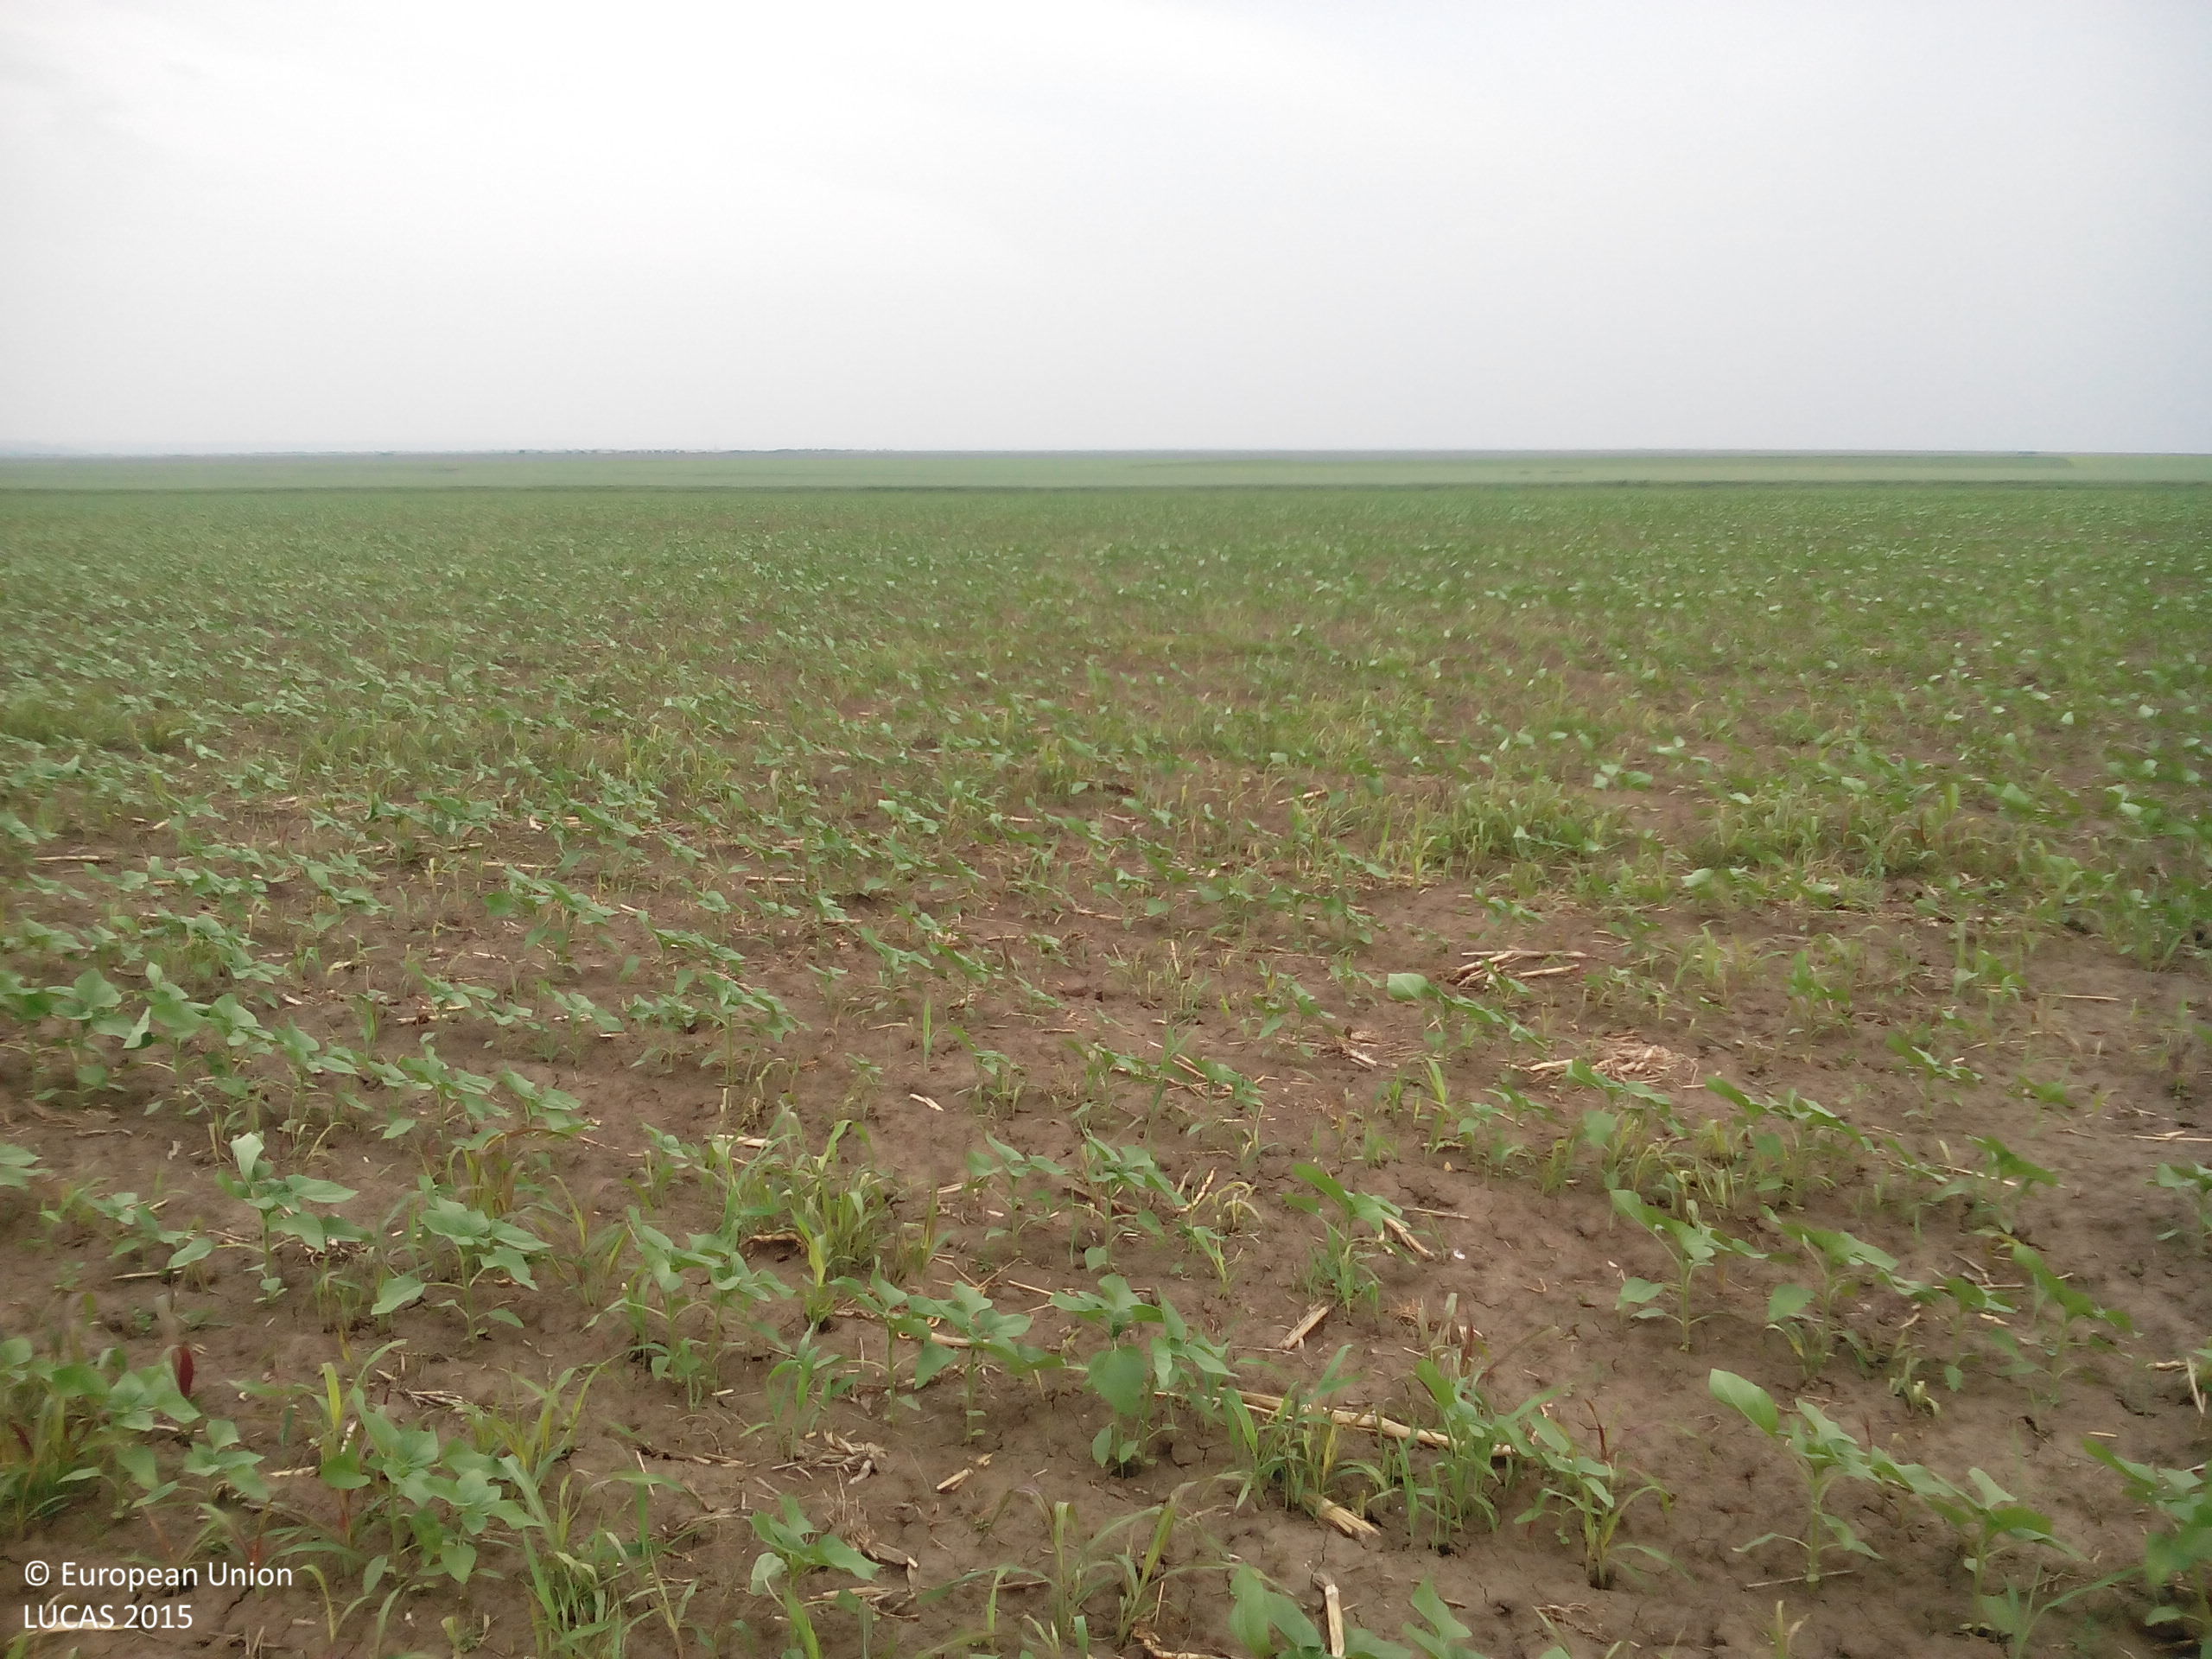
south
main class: Cropland
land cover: Sunflower
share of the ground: 25 - 50 %
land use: Agriculture (excluding fallow land and kitchen gardens)
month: May
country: BG
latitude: 43.6070
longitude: 24.1934
